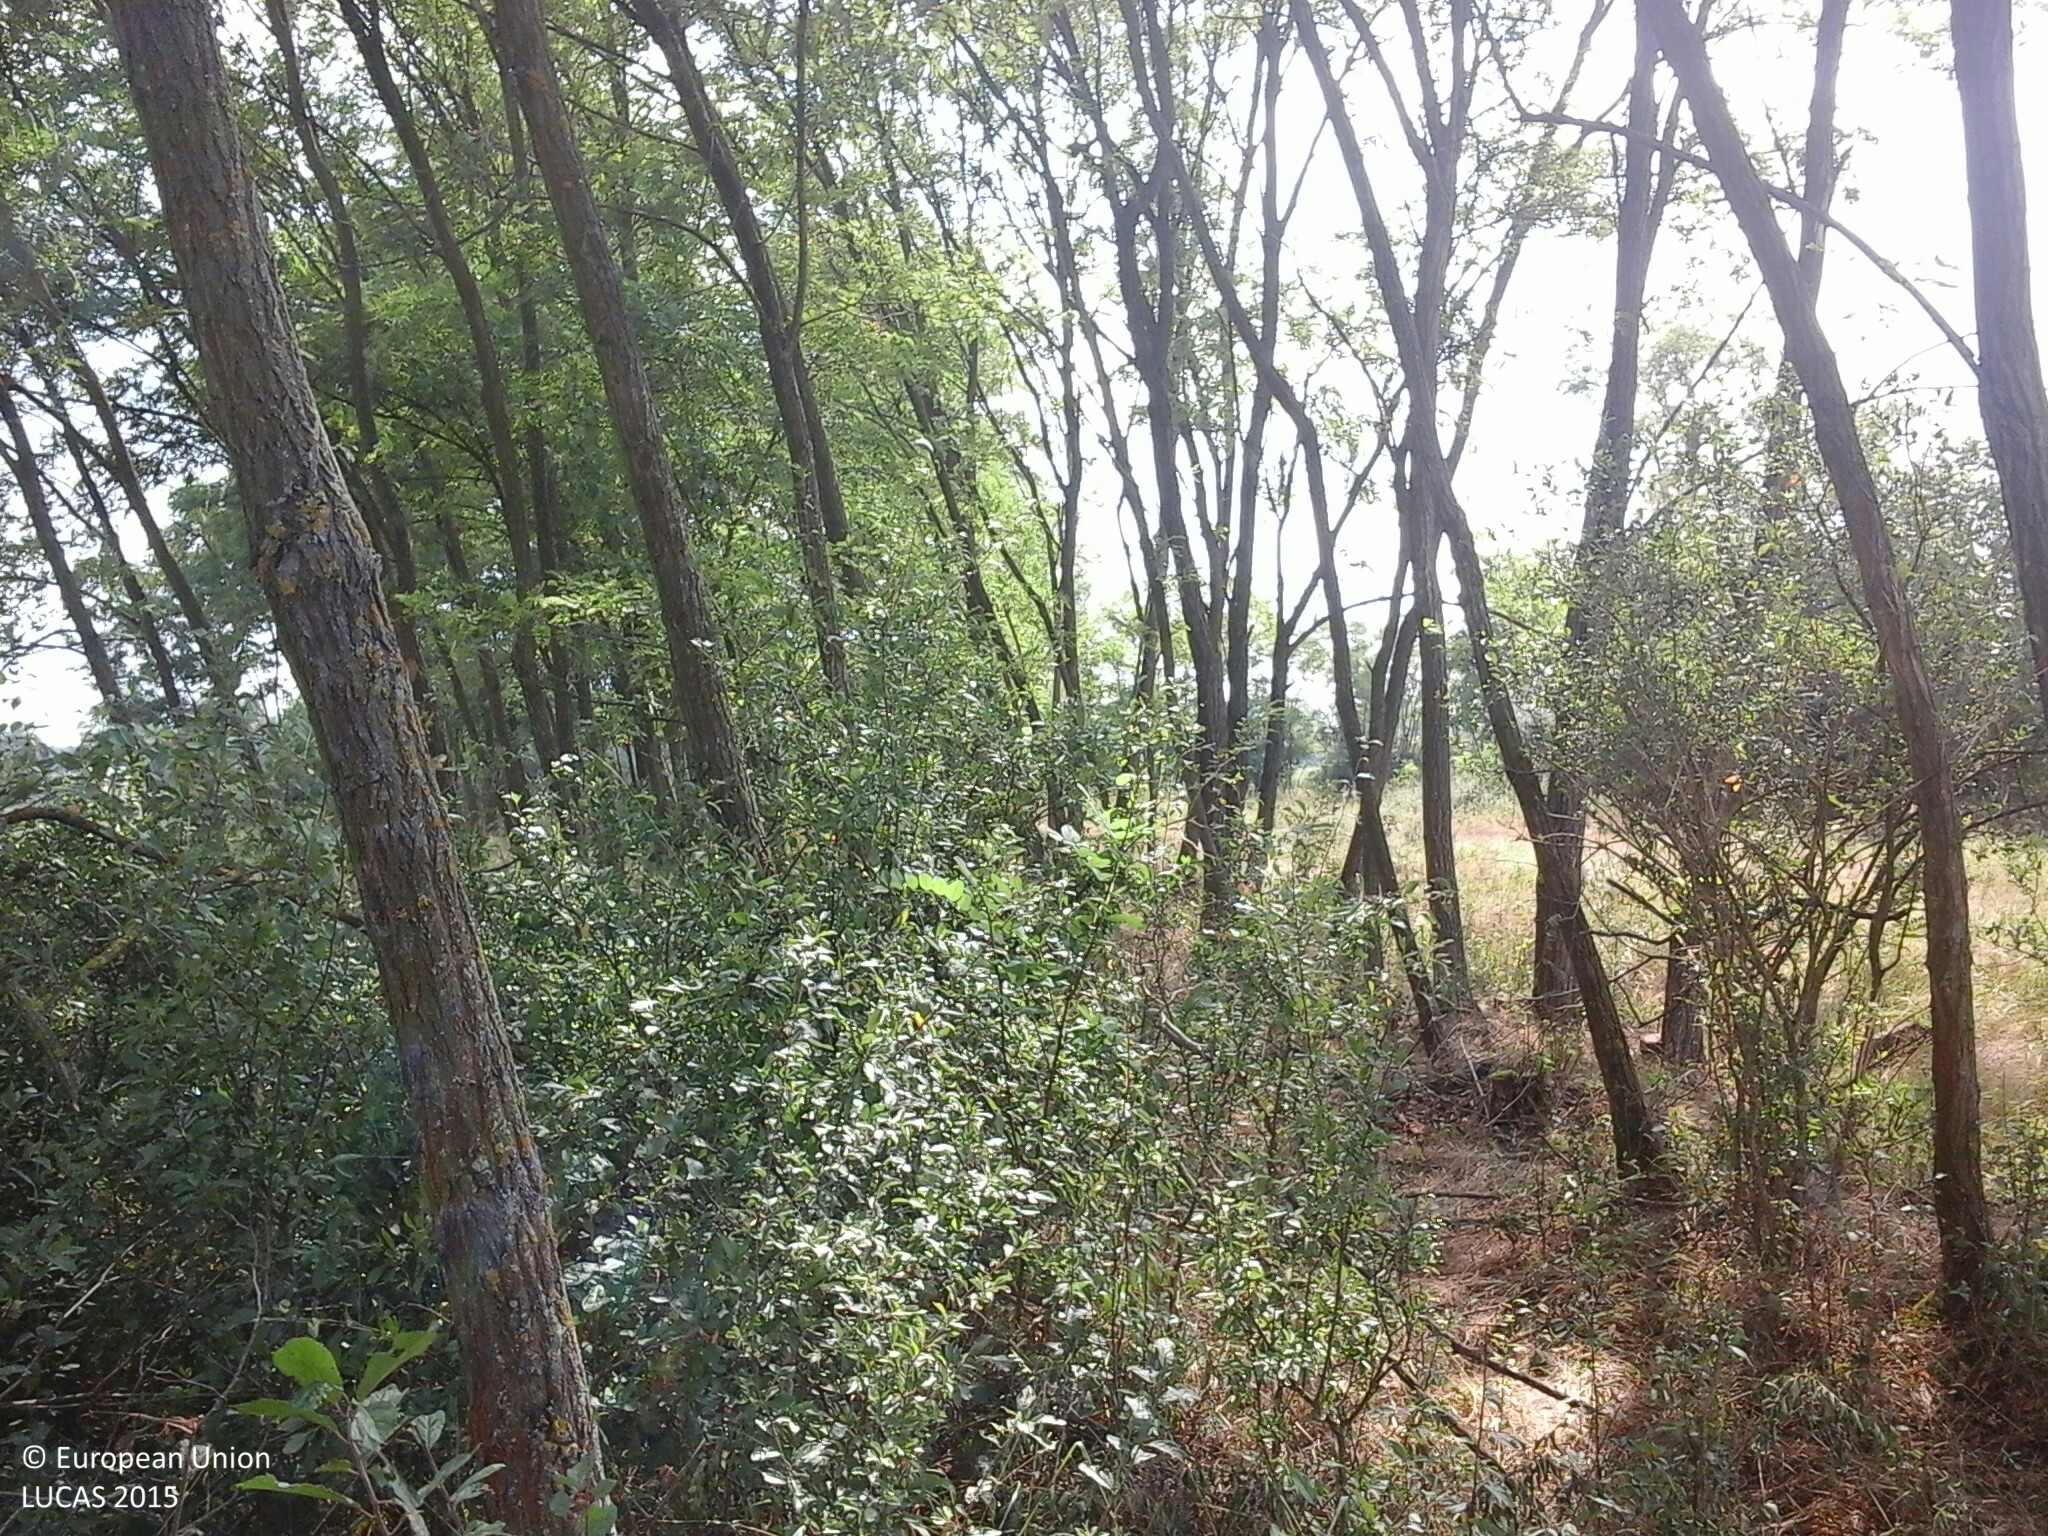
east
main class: Woodland
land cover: Broadleaved woodland
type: exotic forest
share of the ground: > 75 %
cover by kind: broadleaved forest trees 85 %, shrubs 10 %, herbaceous plants 5 %
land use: Forestry
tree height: > 5 m
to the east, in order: Broadleaved woodland; Grassland without tree/shrub cover; Shruby margins; Grass margins; Ditches and canals; Grass margins; Grassland without tree/shrub cover; Inland marshes; Lines of trees; Grassland without tree/shrub cover
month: July
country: HU
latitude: 48.2120
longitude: 22.3997
